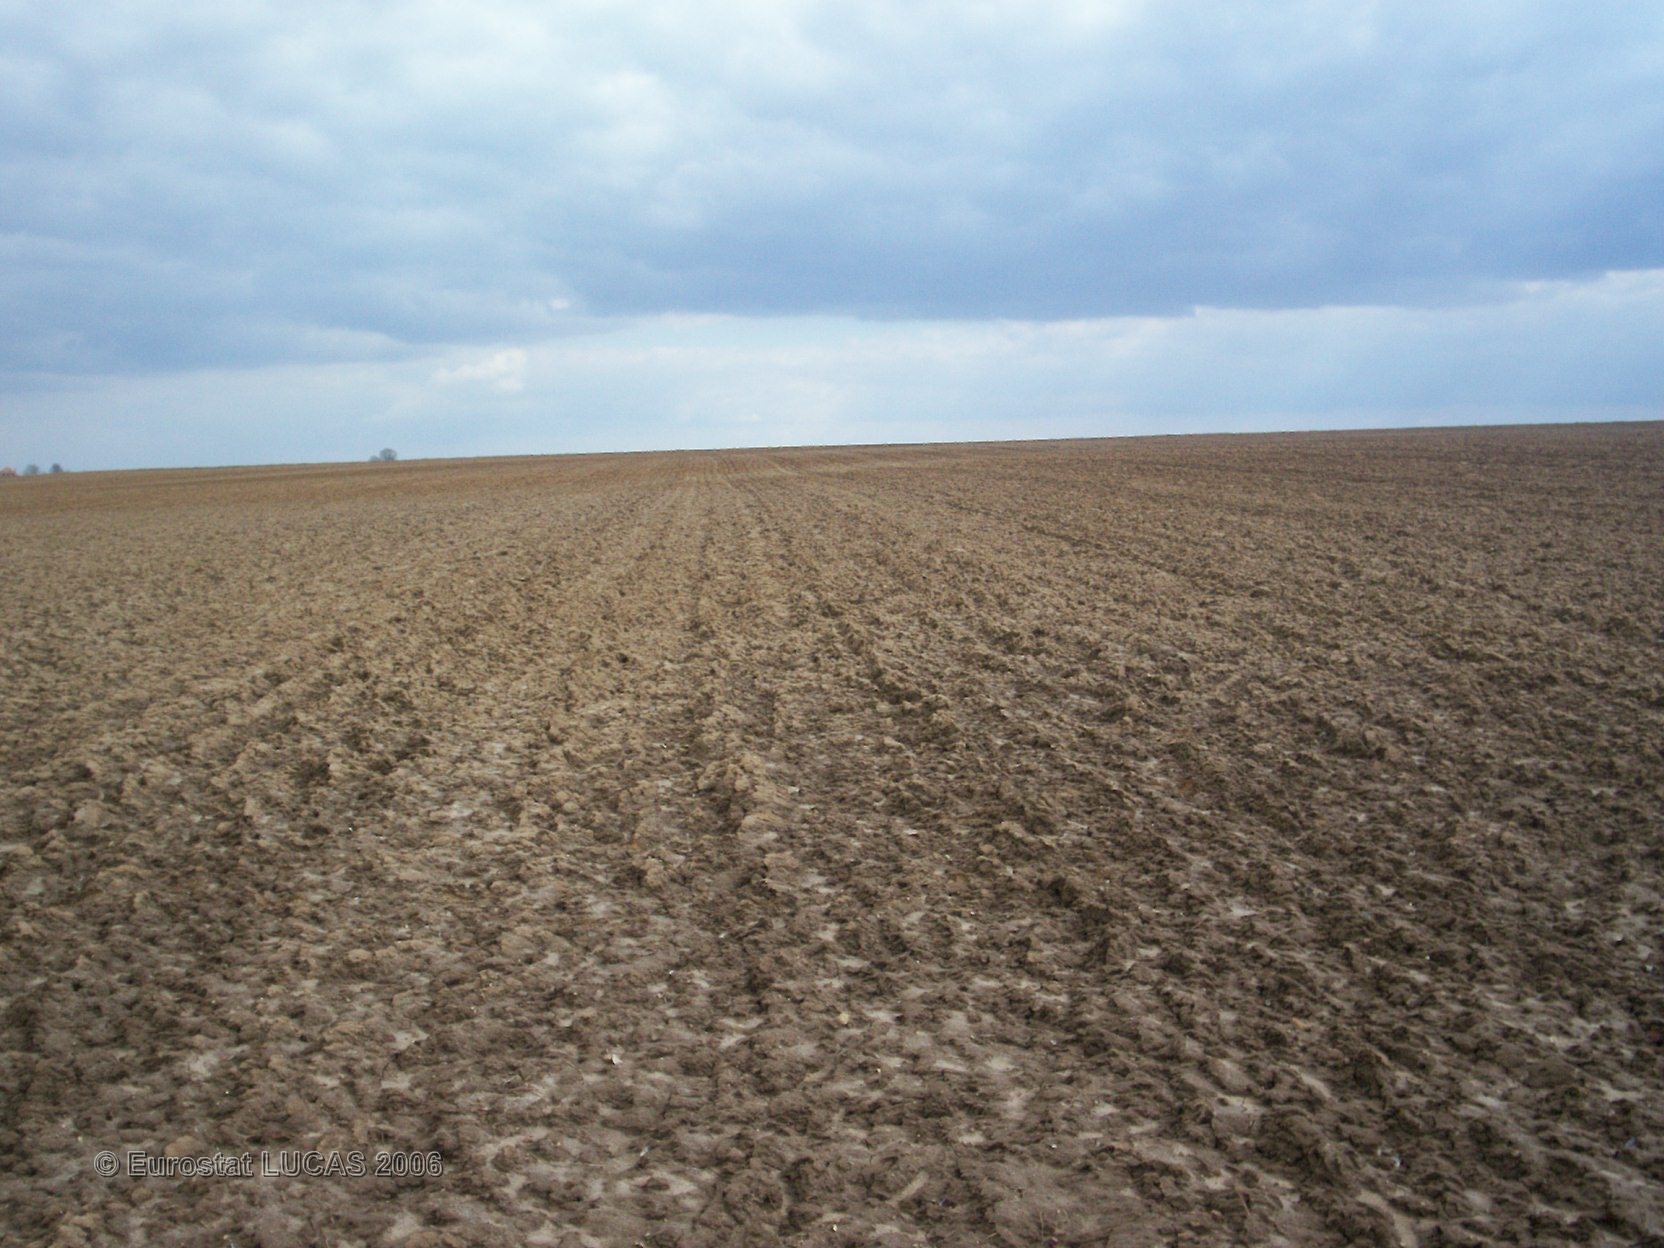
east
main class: Cropland
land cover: Maize
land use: Agriculture (excluding fallow land and kitchen gardens)
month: June
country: FR
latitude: 50.1001
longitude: 2.5081
